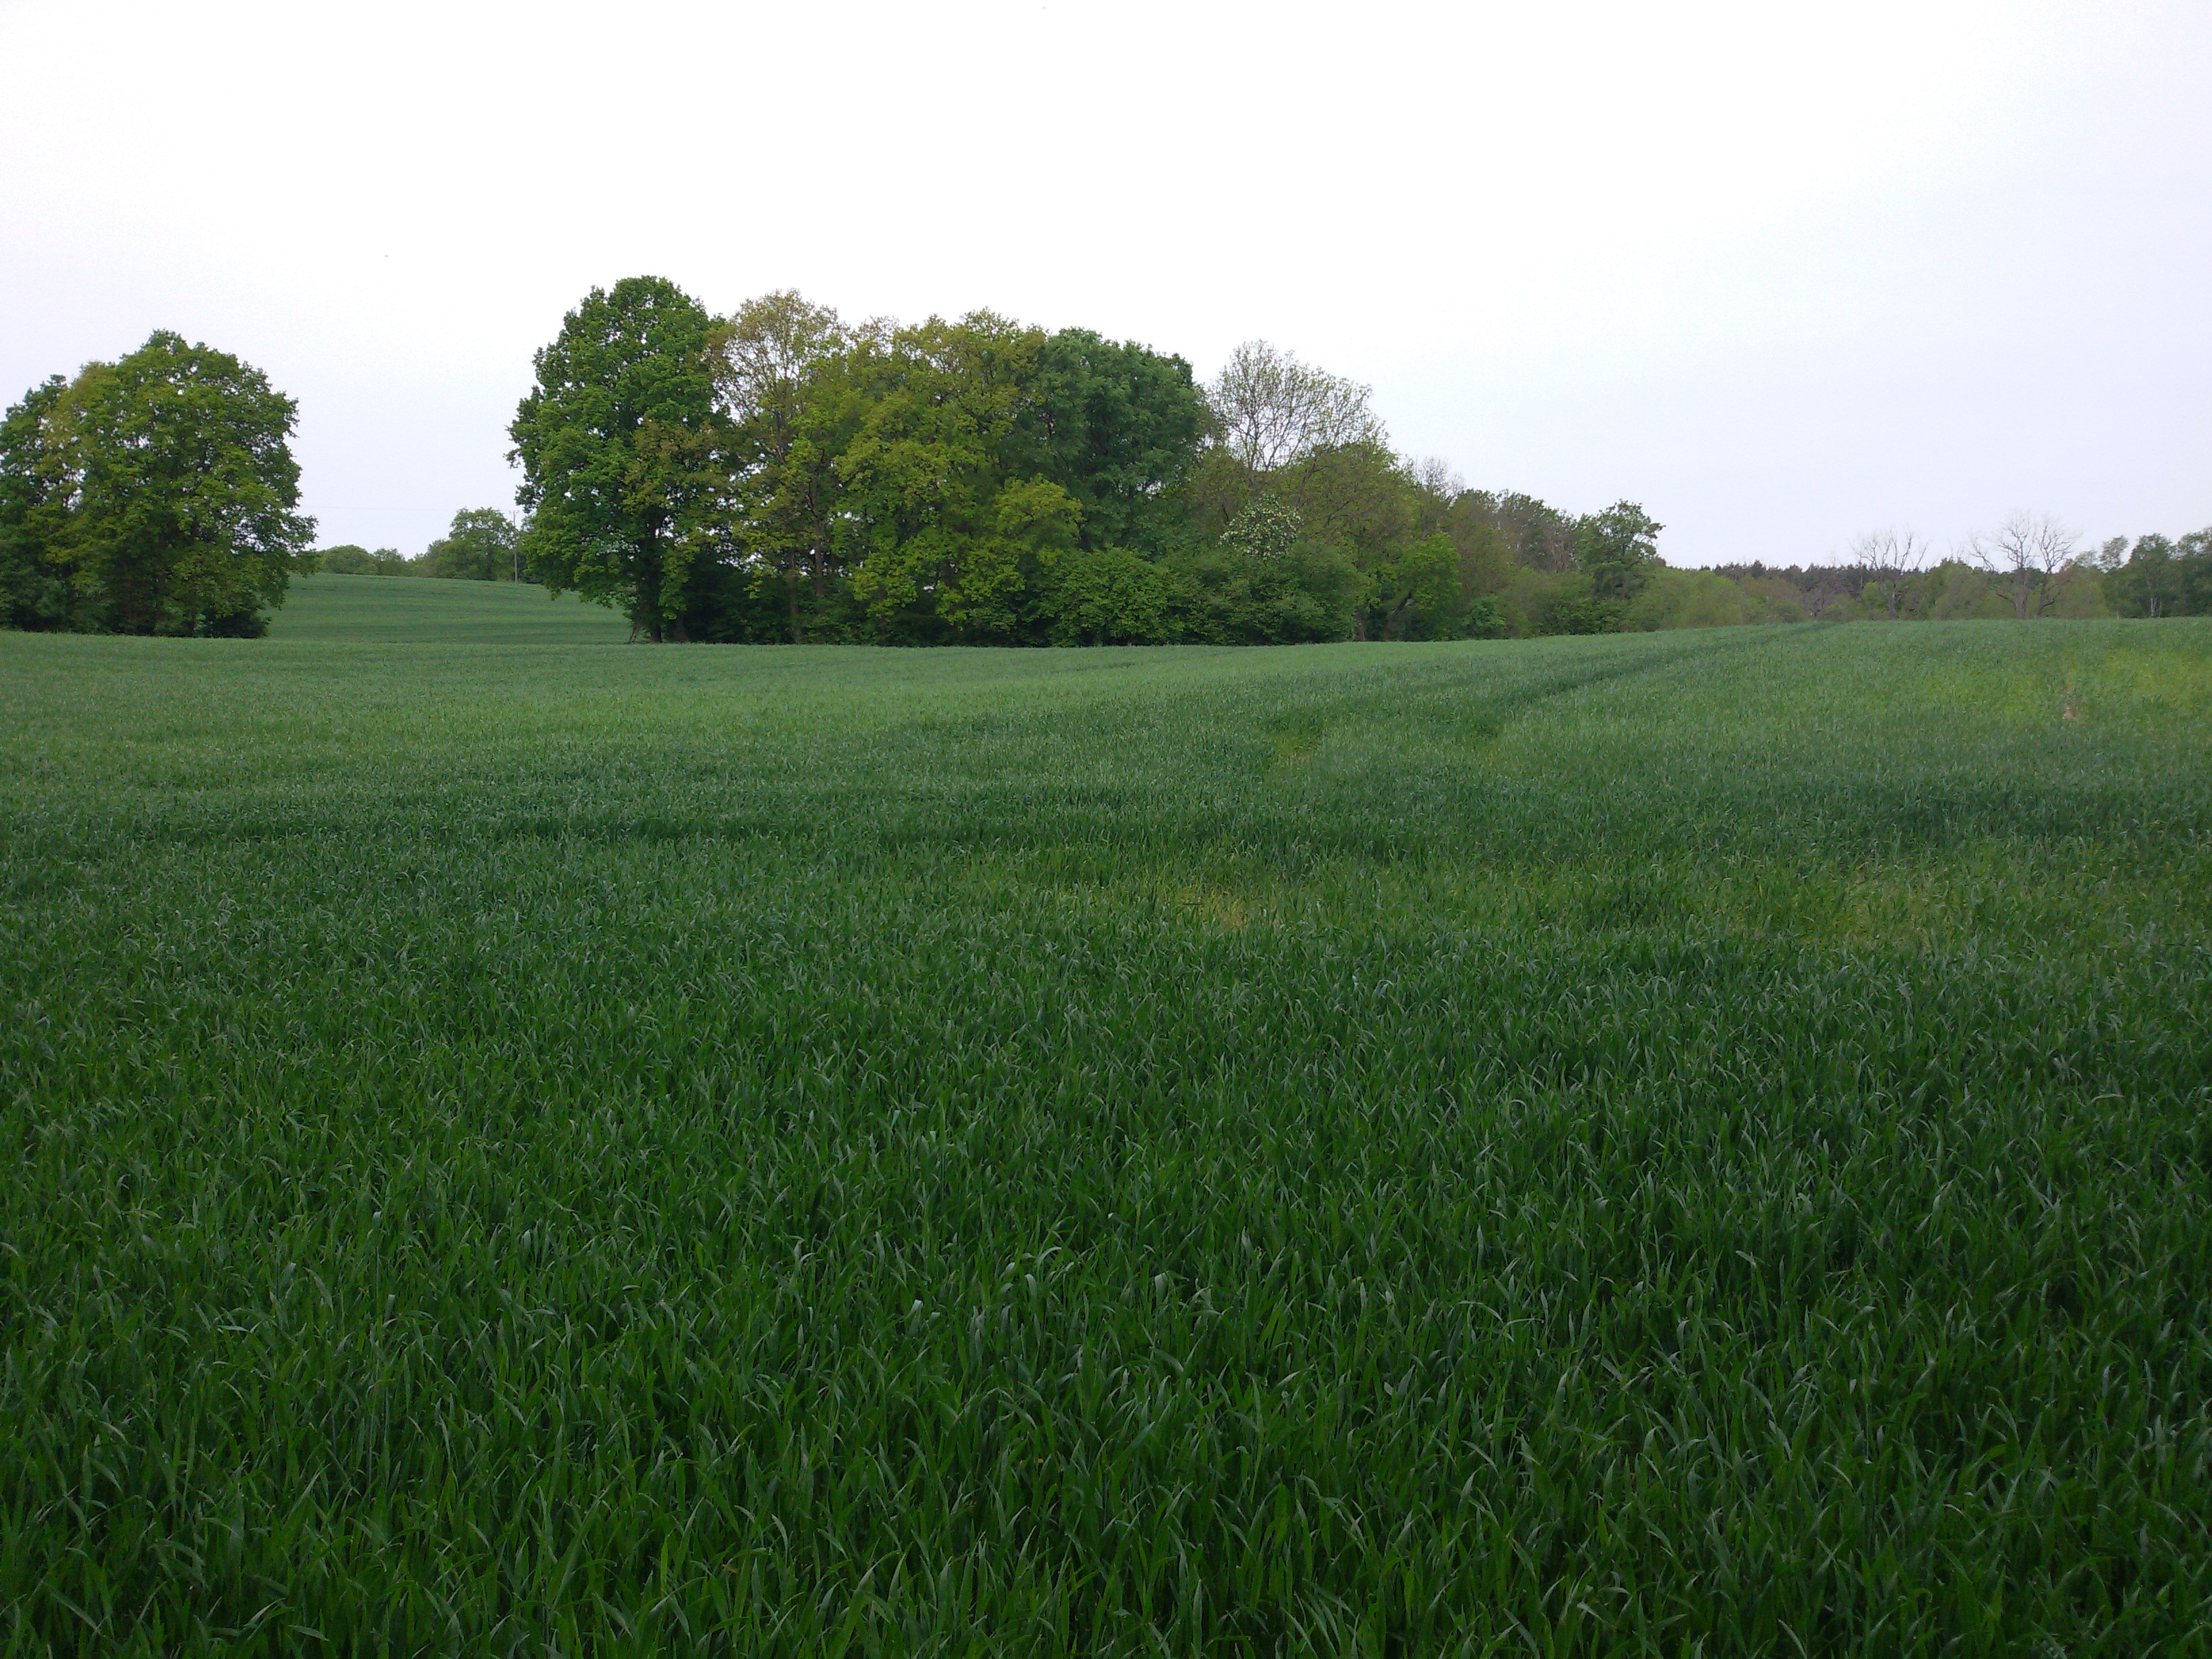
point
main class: Cropland
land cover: Oats
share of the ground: > 75 %
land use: Agriculture (excluding fallow land and kitchen gardens)
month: May
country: PL
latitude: 53.5226
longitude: 14.3297
